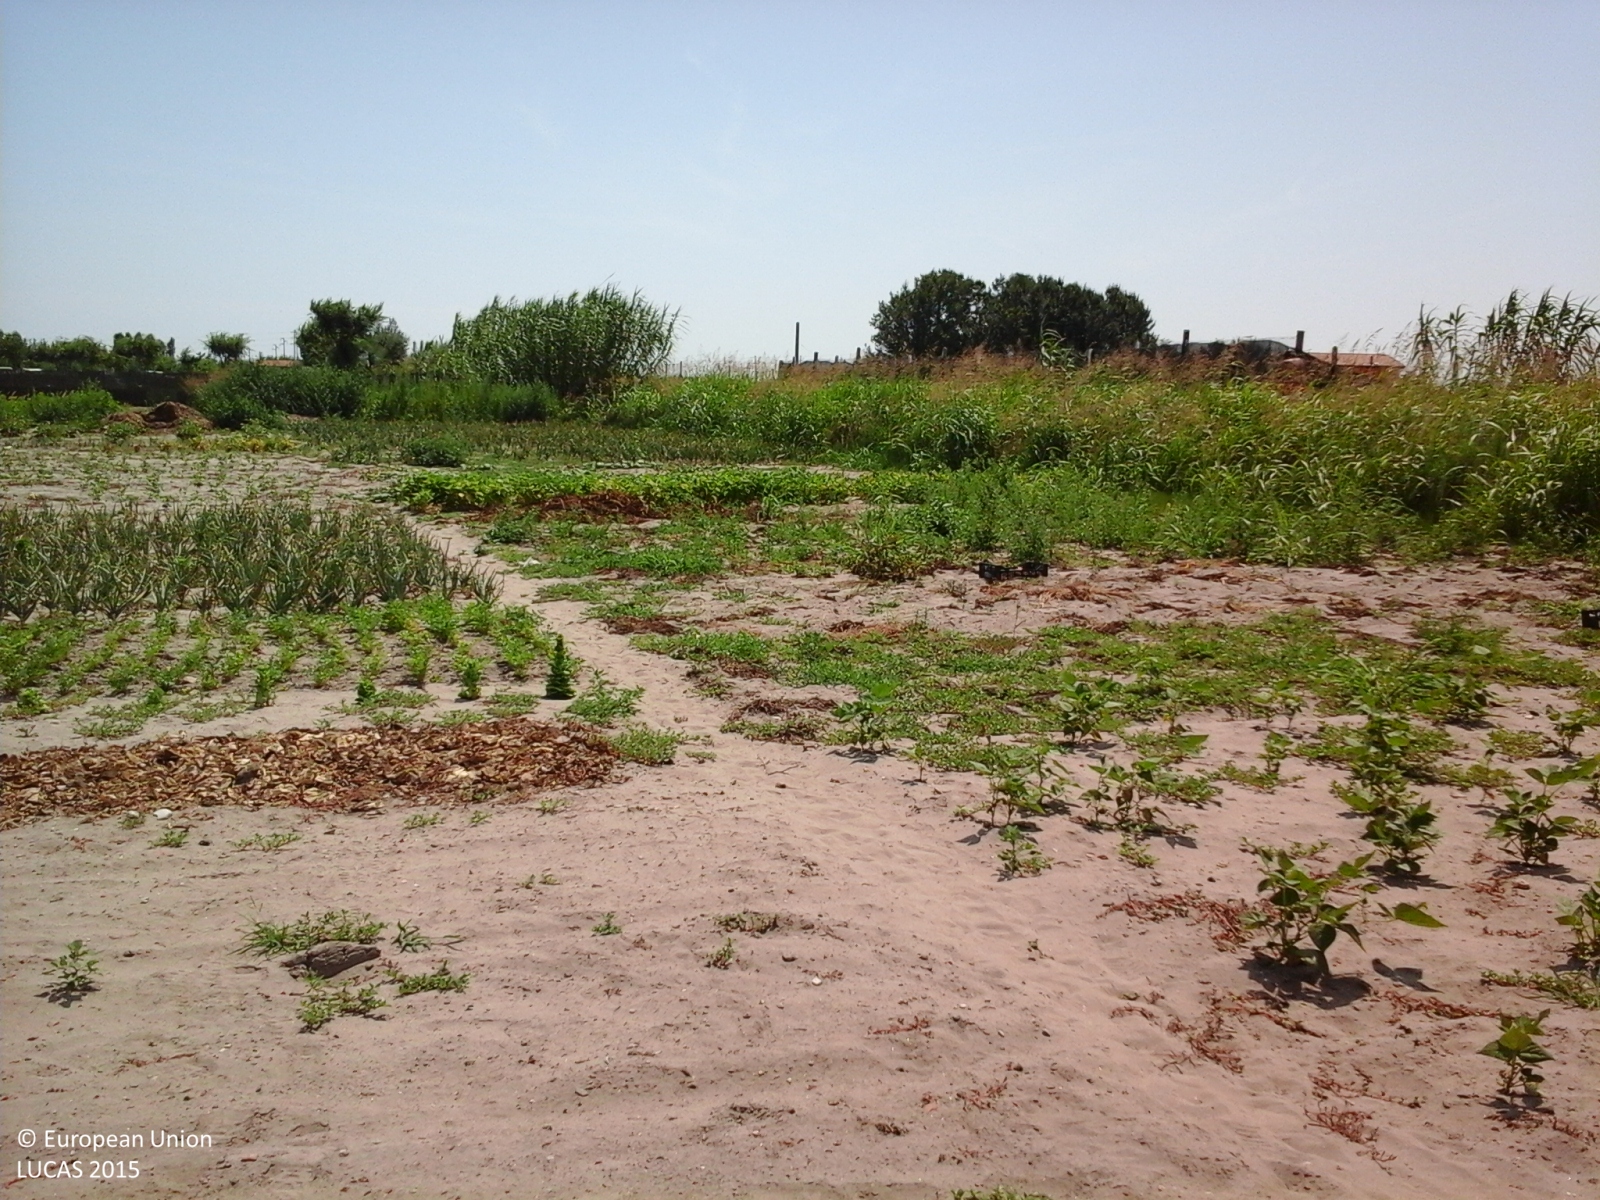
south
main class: Cropland
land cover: Other fresh vegetables
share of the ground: 10 - 25 %
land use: Agriculture (excluding fallow land and kitchen gardens)
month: July
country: IT
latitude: 45.1909
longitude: 12.2999
